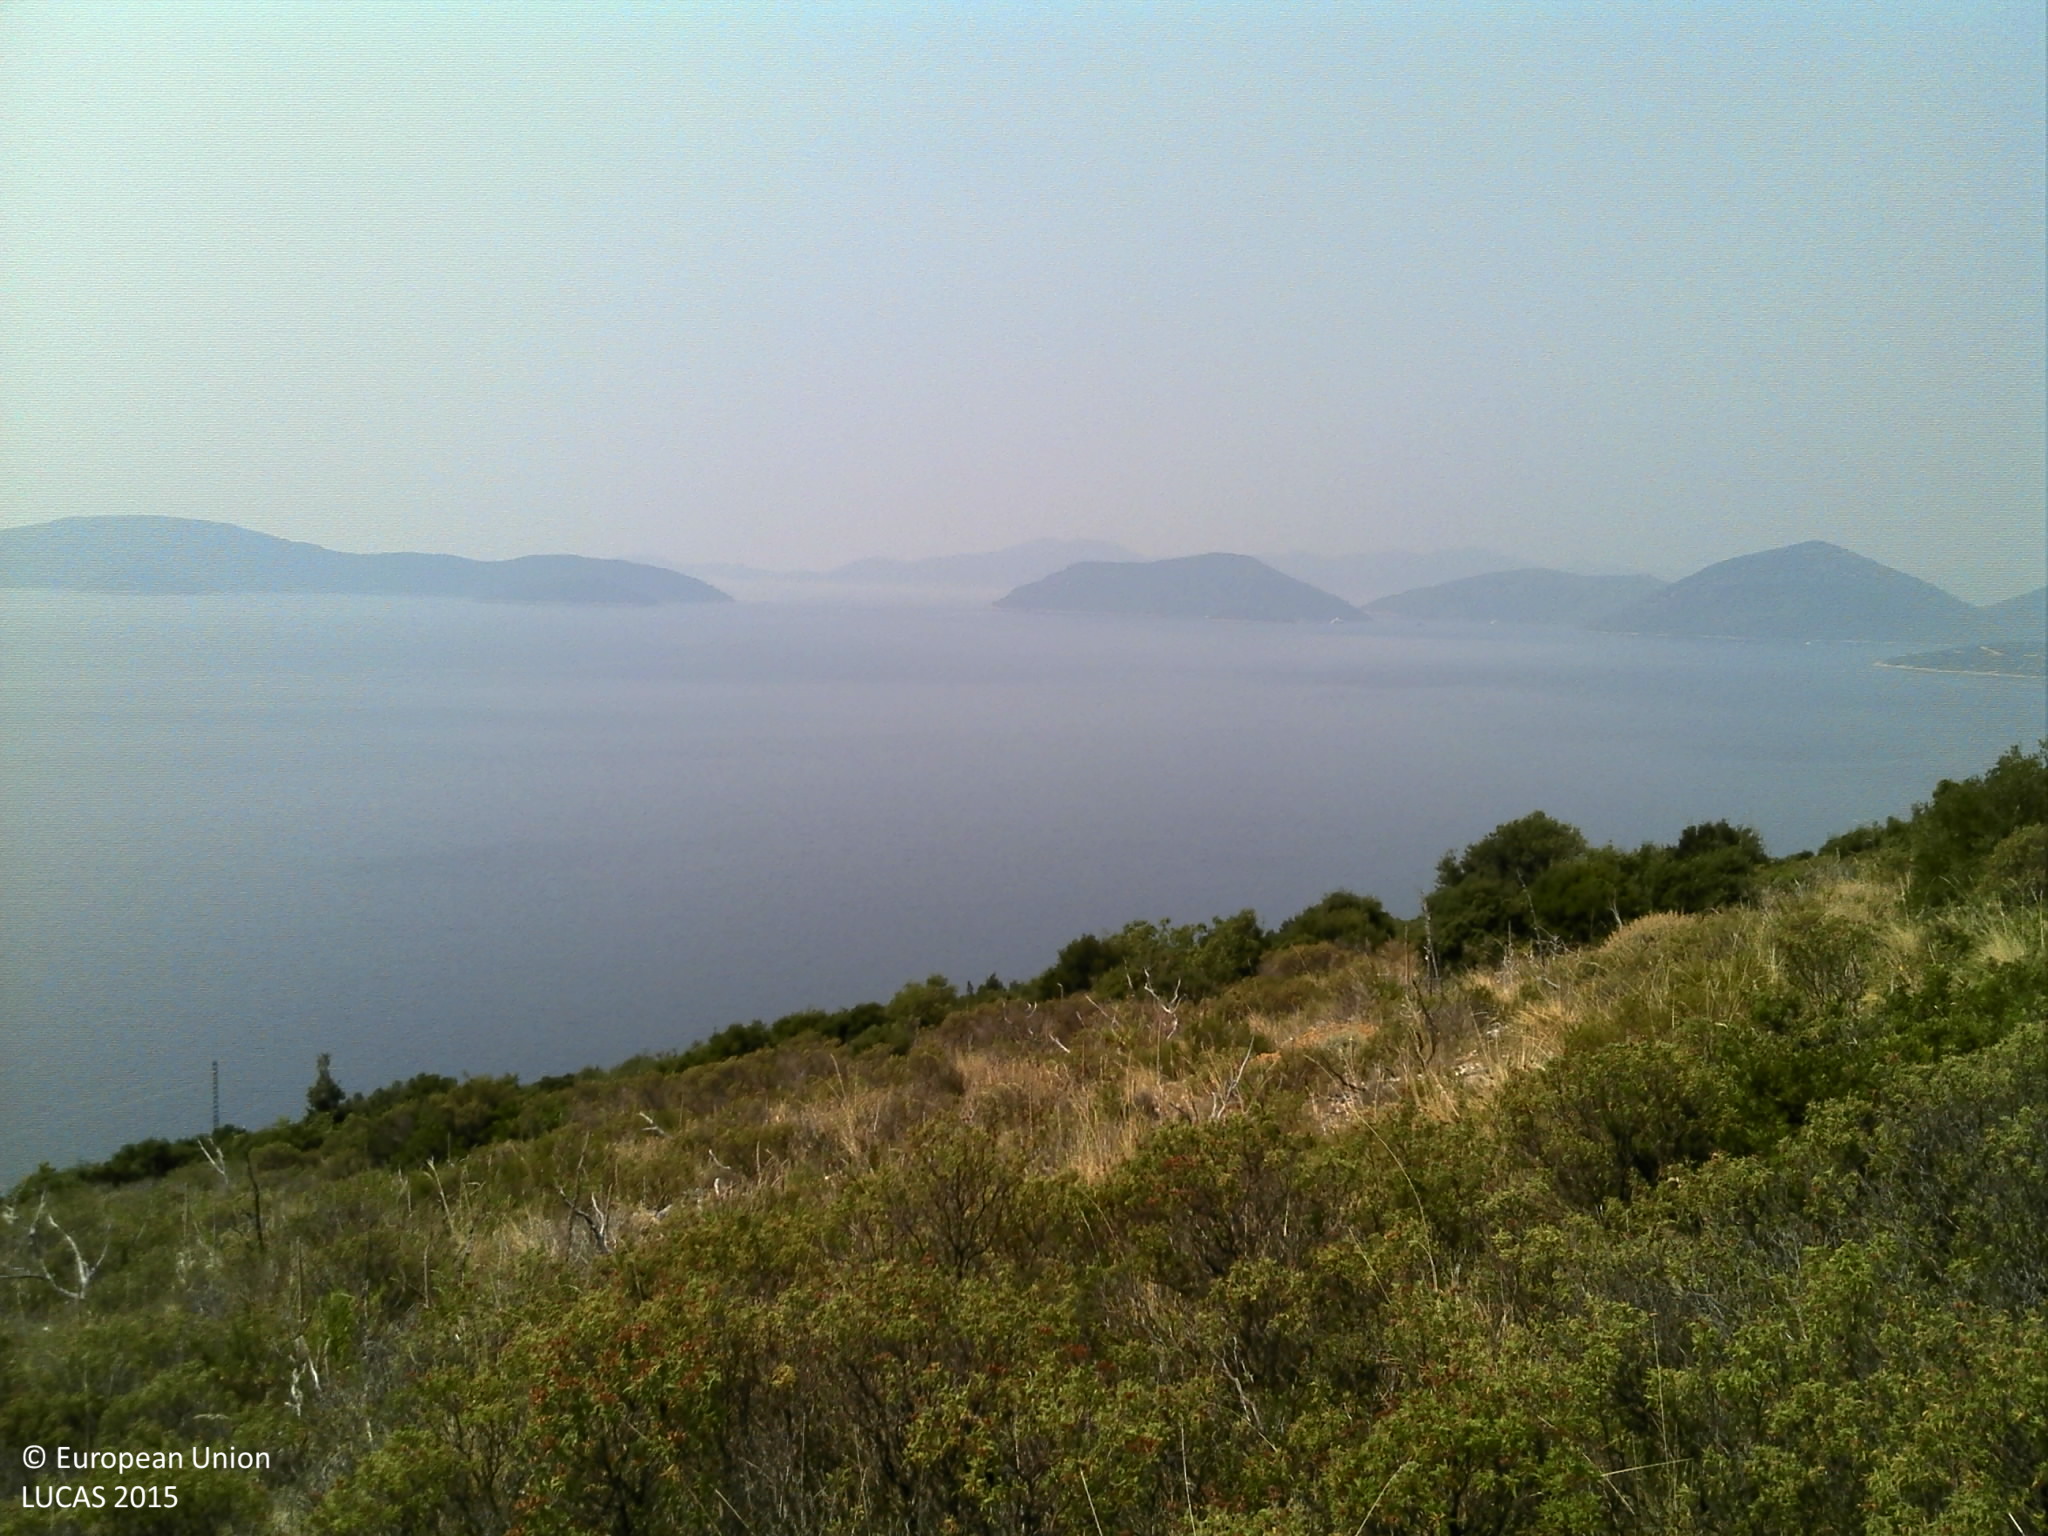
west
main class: Shrubland
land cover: Shrubland without tree cover
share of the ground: 50 - 75 %
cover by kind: shrubs 50 %, herbaceous plants 25 %, consolidated bare surface 25 %
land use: Semi-natural and natural areas not in use
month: July
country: HR
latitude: 42.8041
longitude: 17.8284
